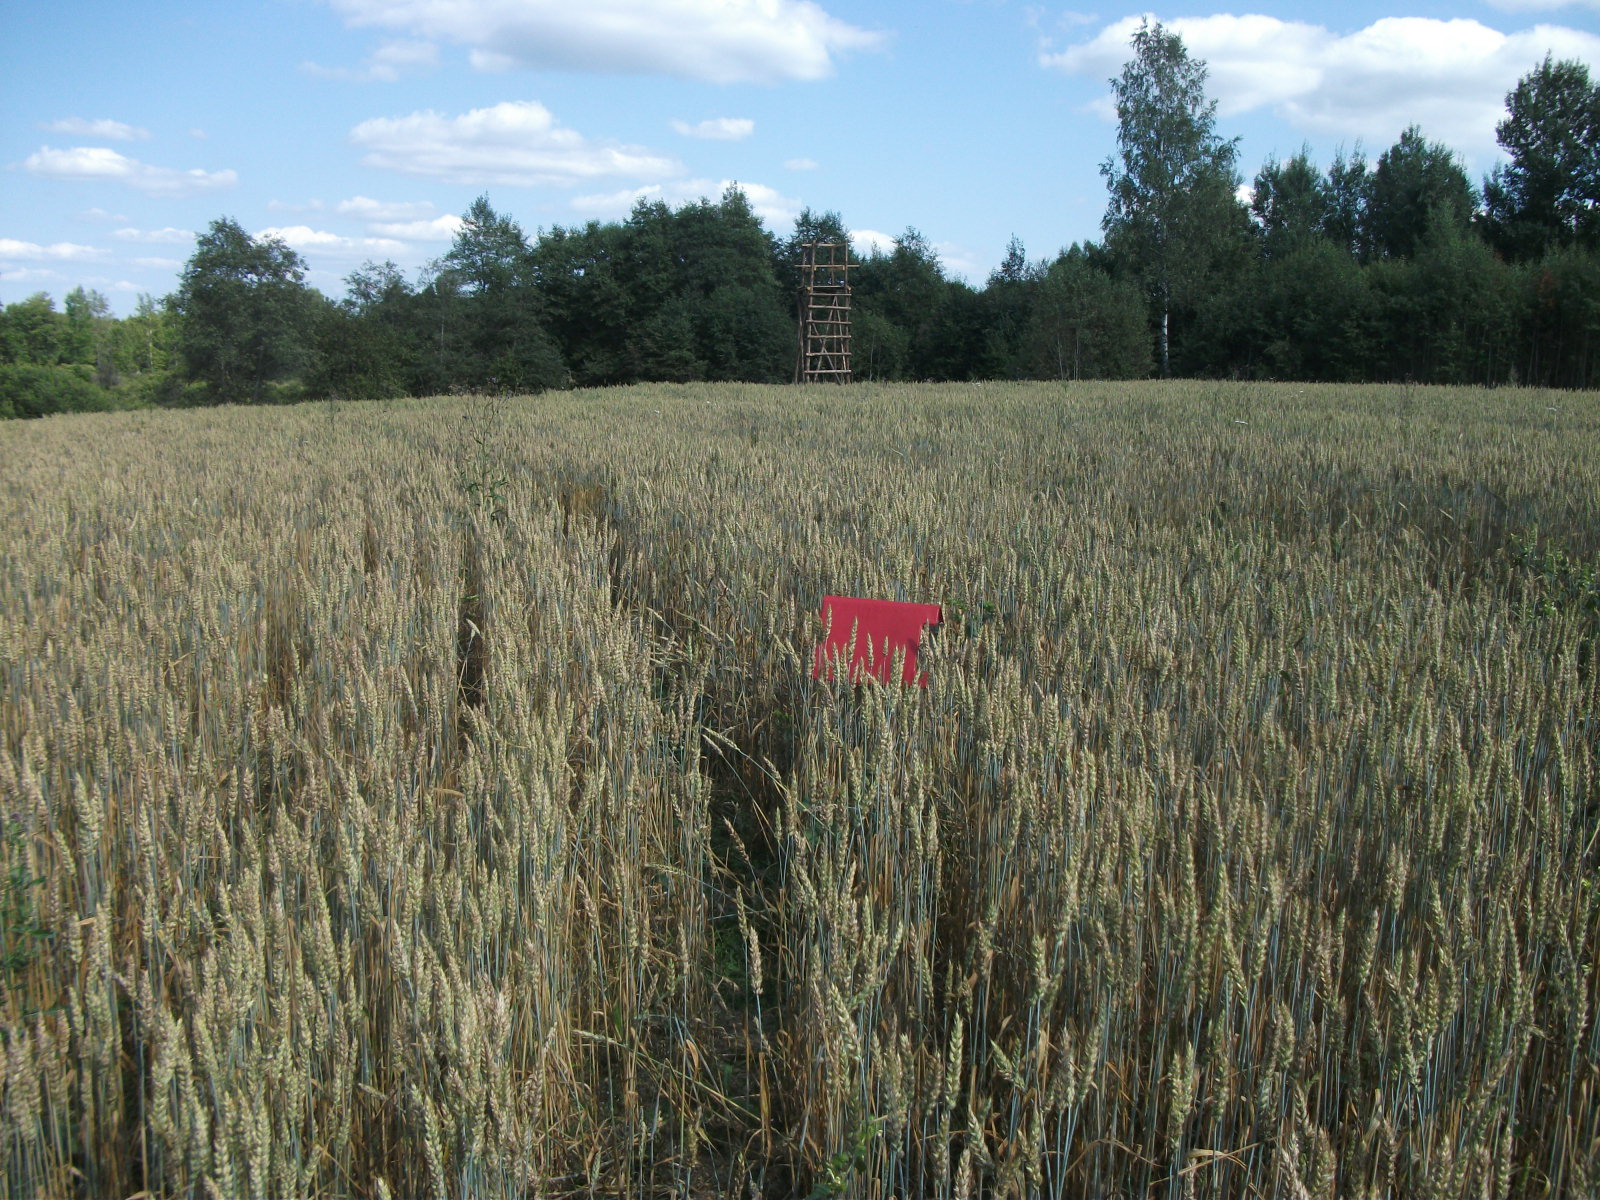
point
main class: Cropland
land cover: Common wheat
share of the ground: > 75 %
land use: Agriculture (excluding fallow land and kitchen gardens)
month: August
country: LV
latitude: 56.8348
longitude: 26.3854
